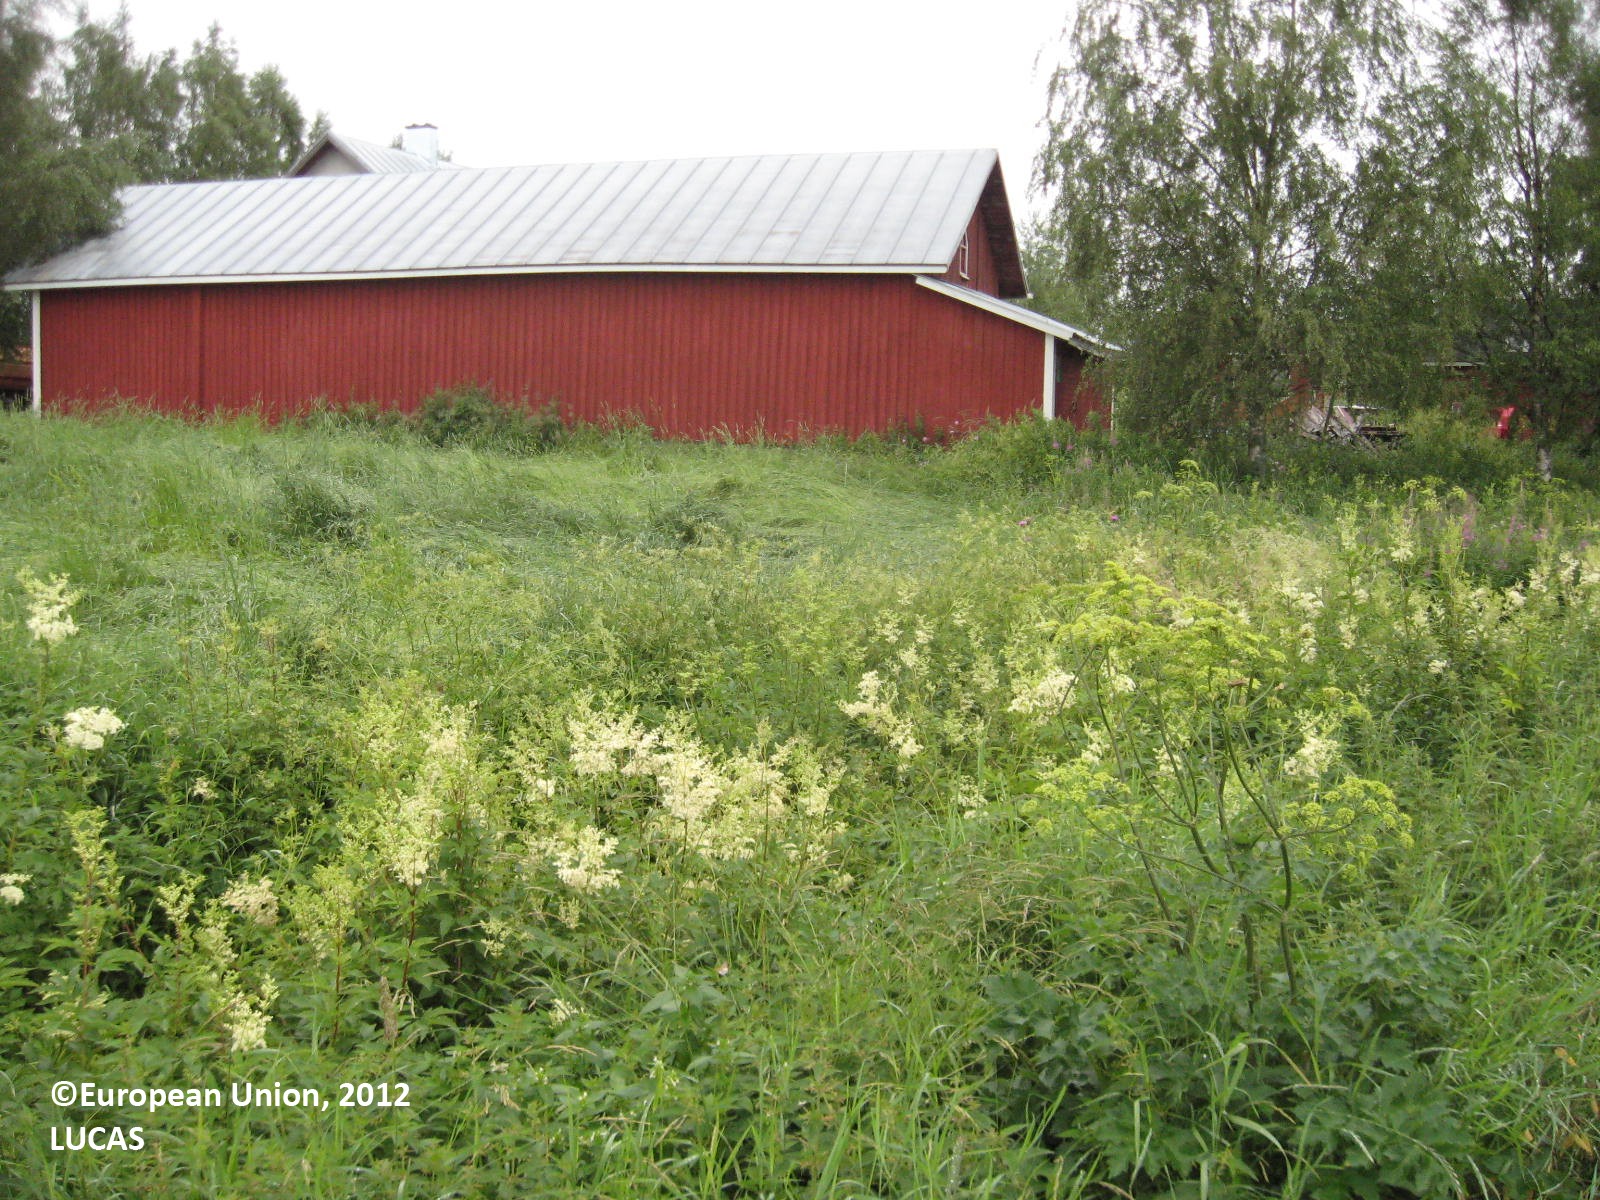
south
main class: Cropland
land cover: Barley
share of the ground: > 75 %
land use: Agriculture (excluding fallow land and kitchen gardens)
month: July
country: FI
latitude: 62.4652
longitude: 21.6992
